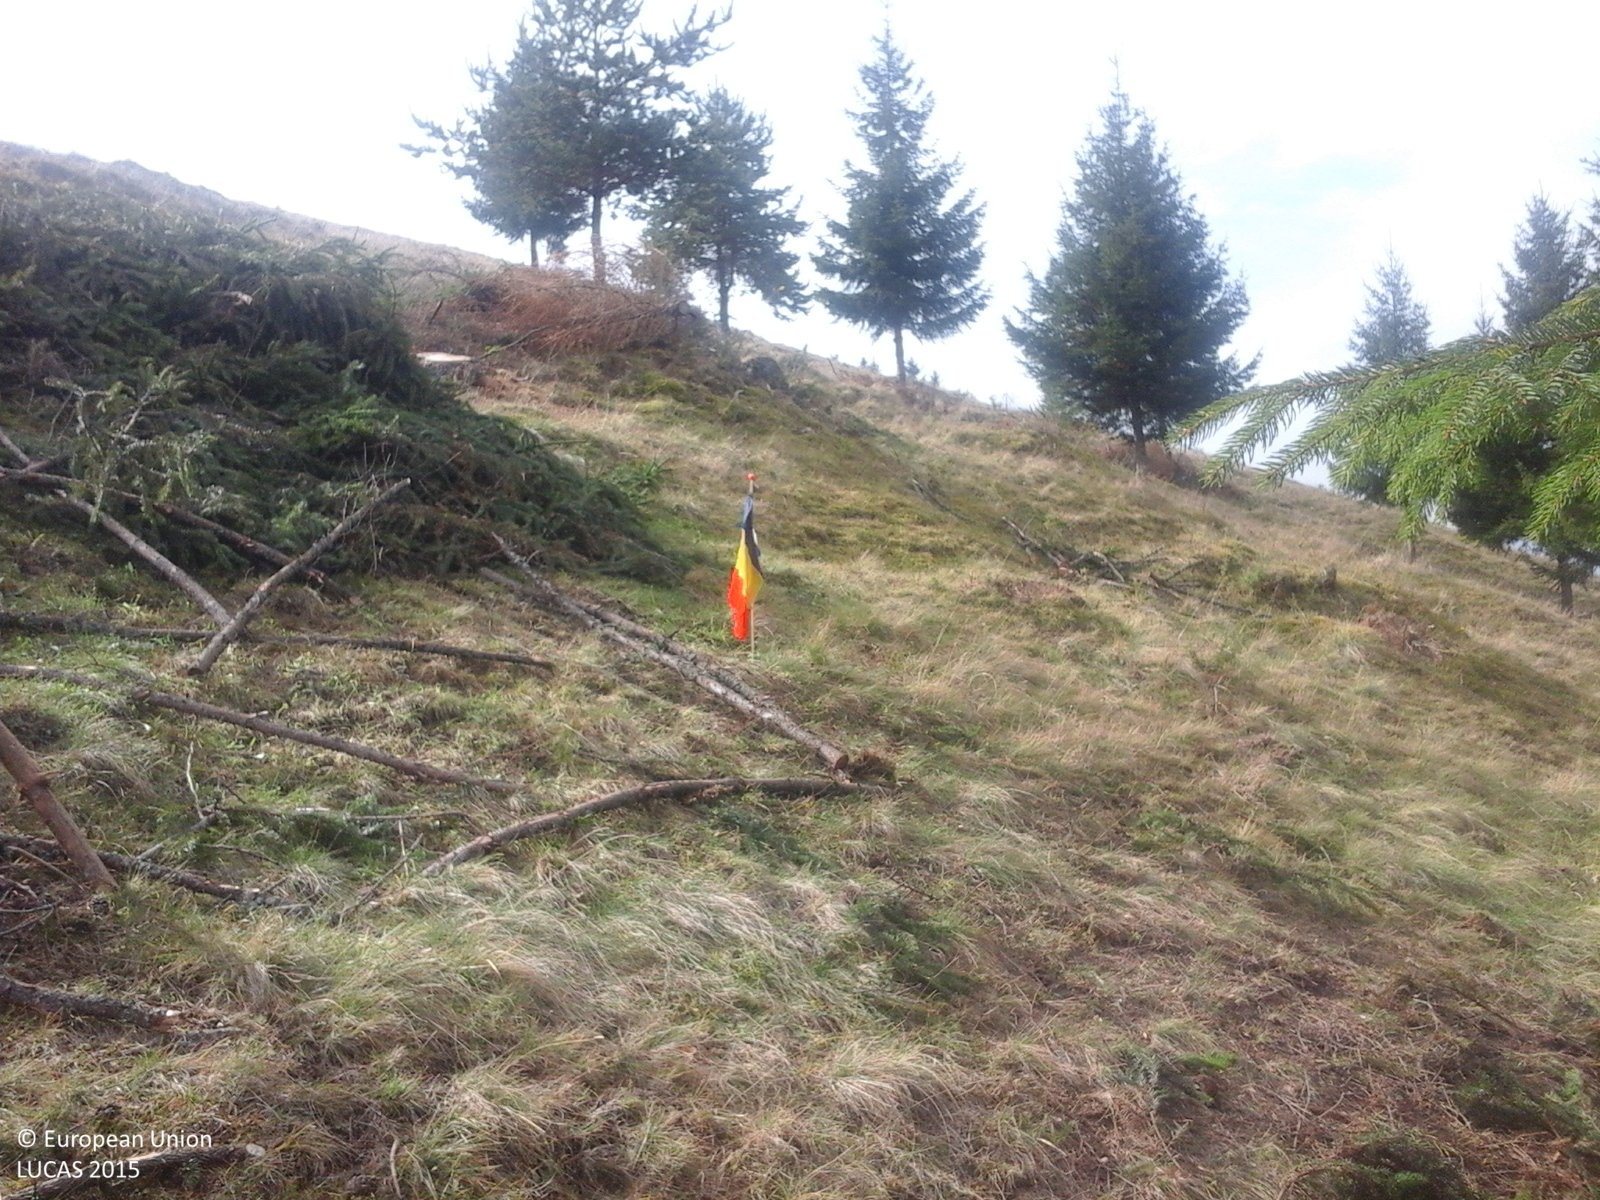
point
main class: Grassland
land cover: Grassland with sparse tree/shrub cover
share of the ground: > 75 %
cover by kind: herbaceous plants 85 %, shrubs 10 %, broadleaved forest trees 5 %
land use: Fallow land
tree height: > 5 m
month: October
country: RO
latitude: 46.4957
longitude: 25.8701
